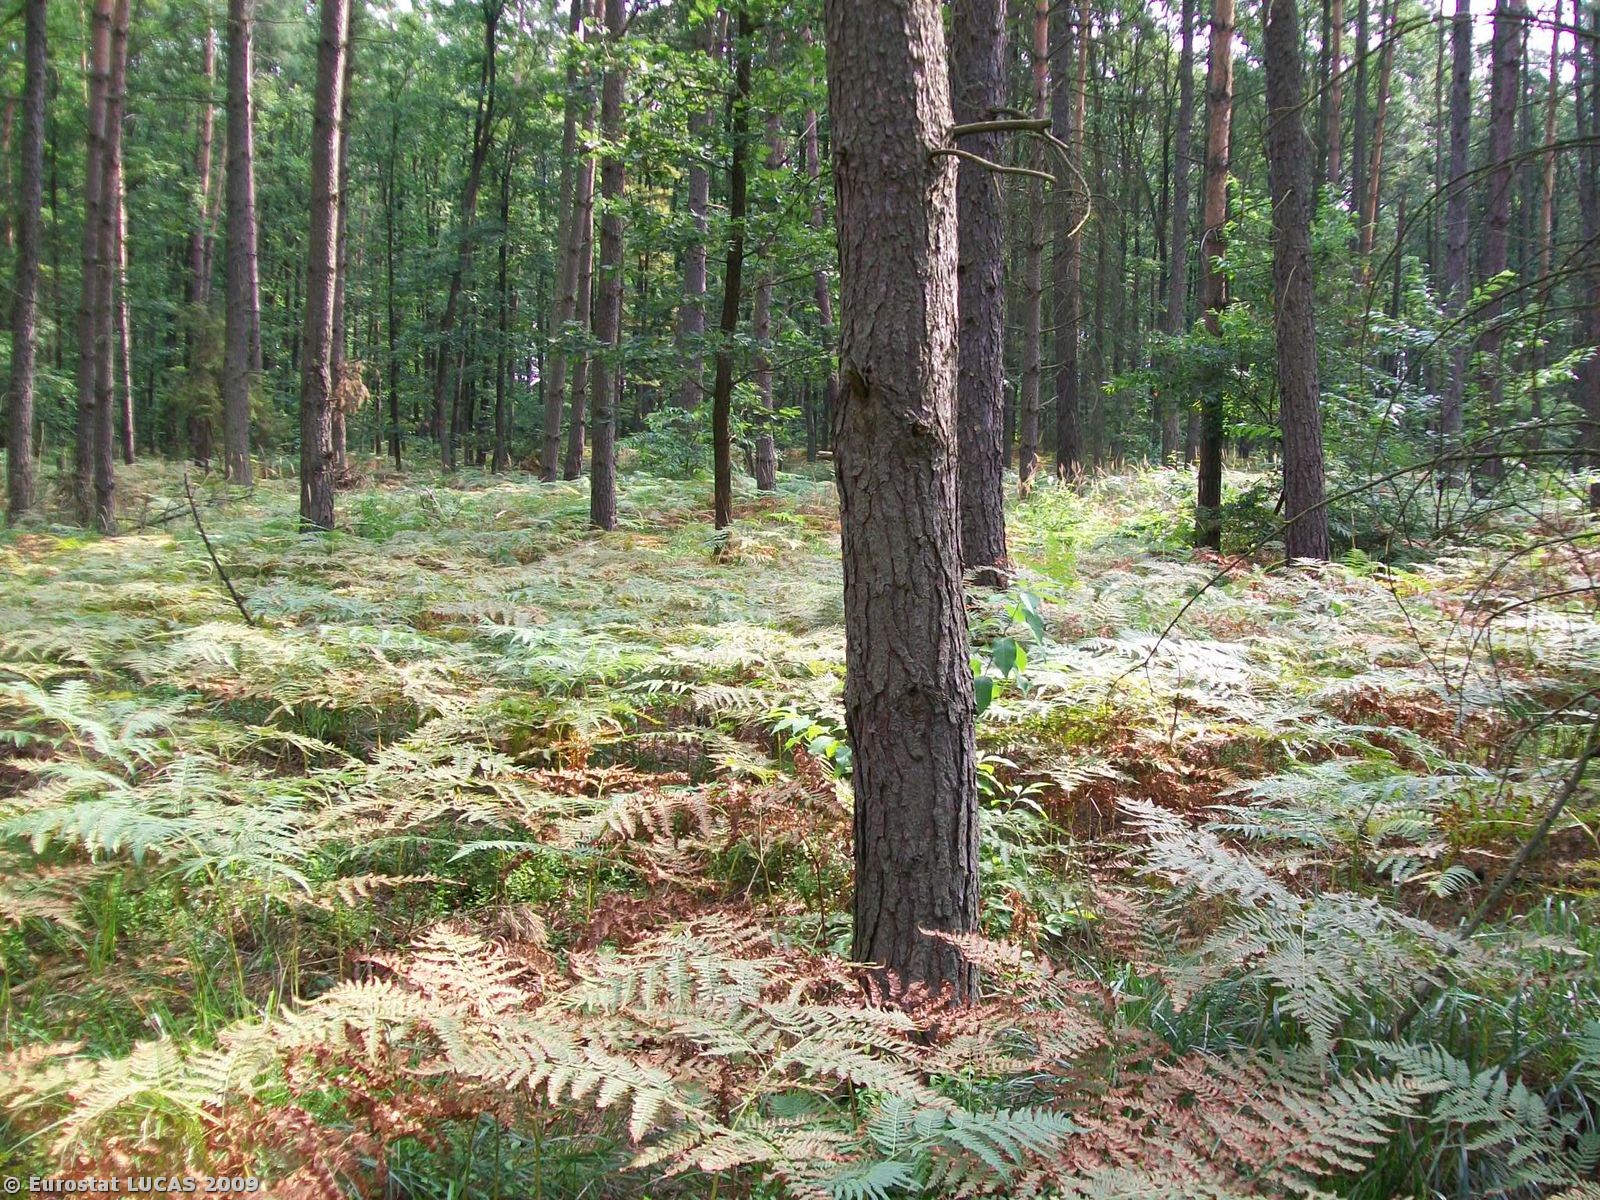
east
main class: Woodland
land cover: Mixed woodland
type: hemiboreal forest and nemoral coniferous forest and mixed broadleaved-coniferous forest
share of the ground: > 75 %
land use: Forestry
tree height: > 5 m
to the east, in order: Mixed woodland; Triticale
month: August
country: PL
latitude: 51.1729
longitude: 17.9250
